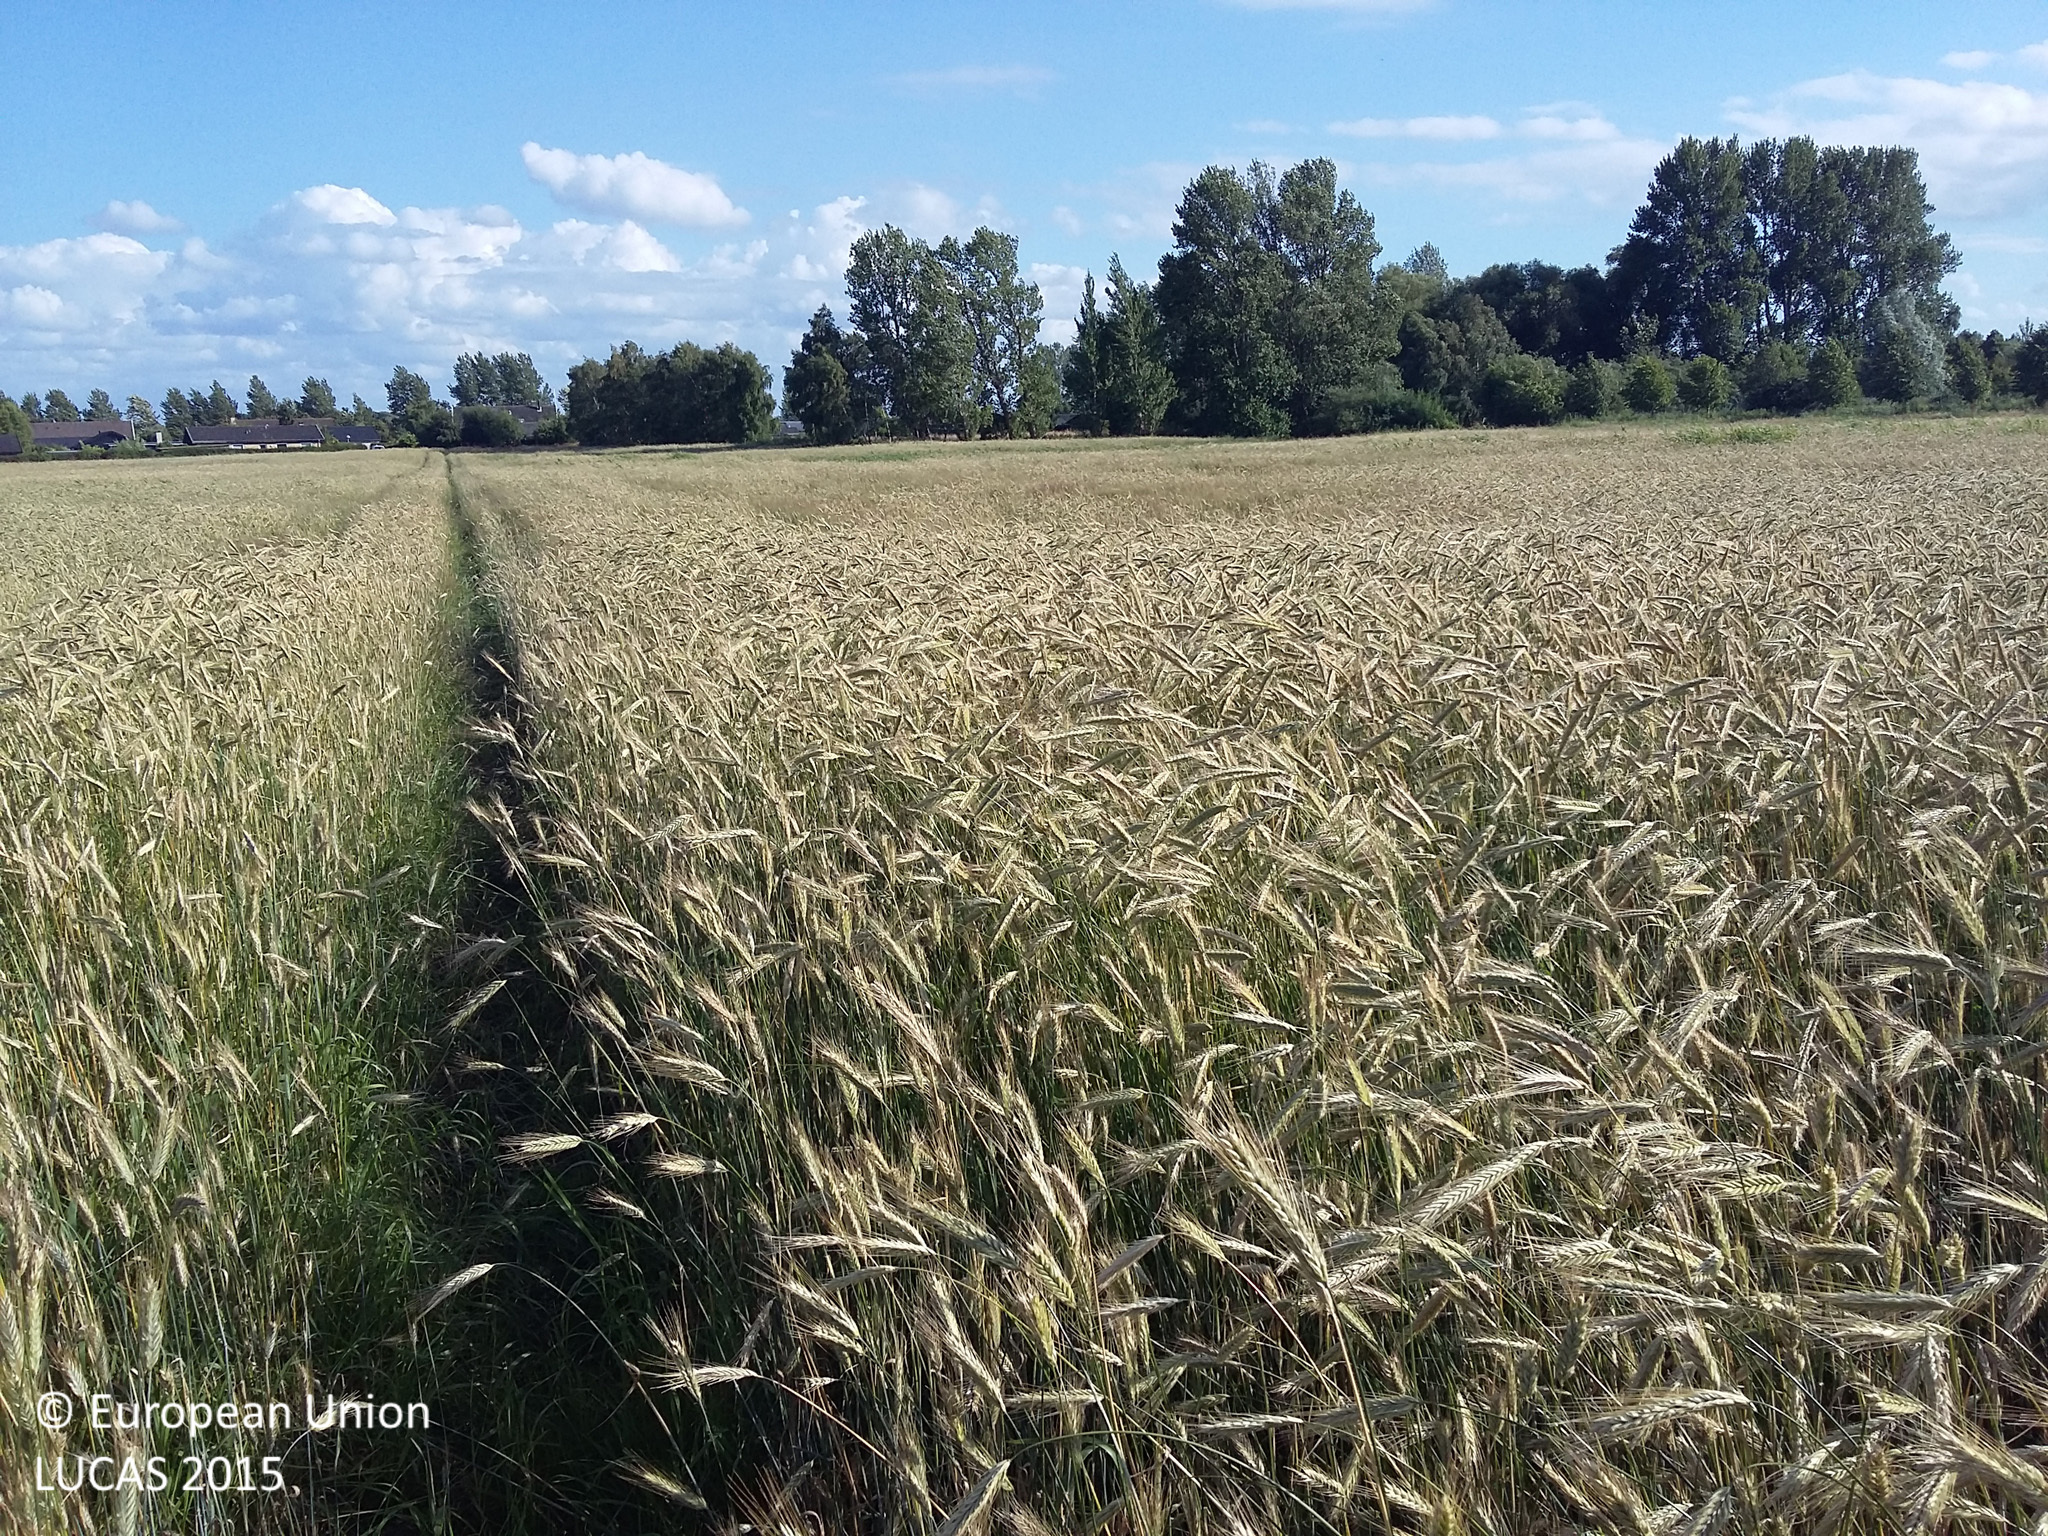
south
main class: Cropland
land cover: Rye
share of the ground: > 75 %
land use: Agriculture (excluding fallow land and kitchen gardens)
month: July
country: DK
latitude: 55.9251
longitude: 11.6787
